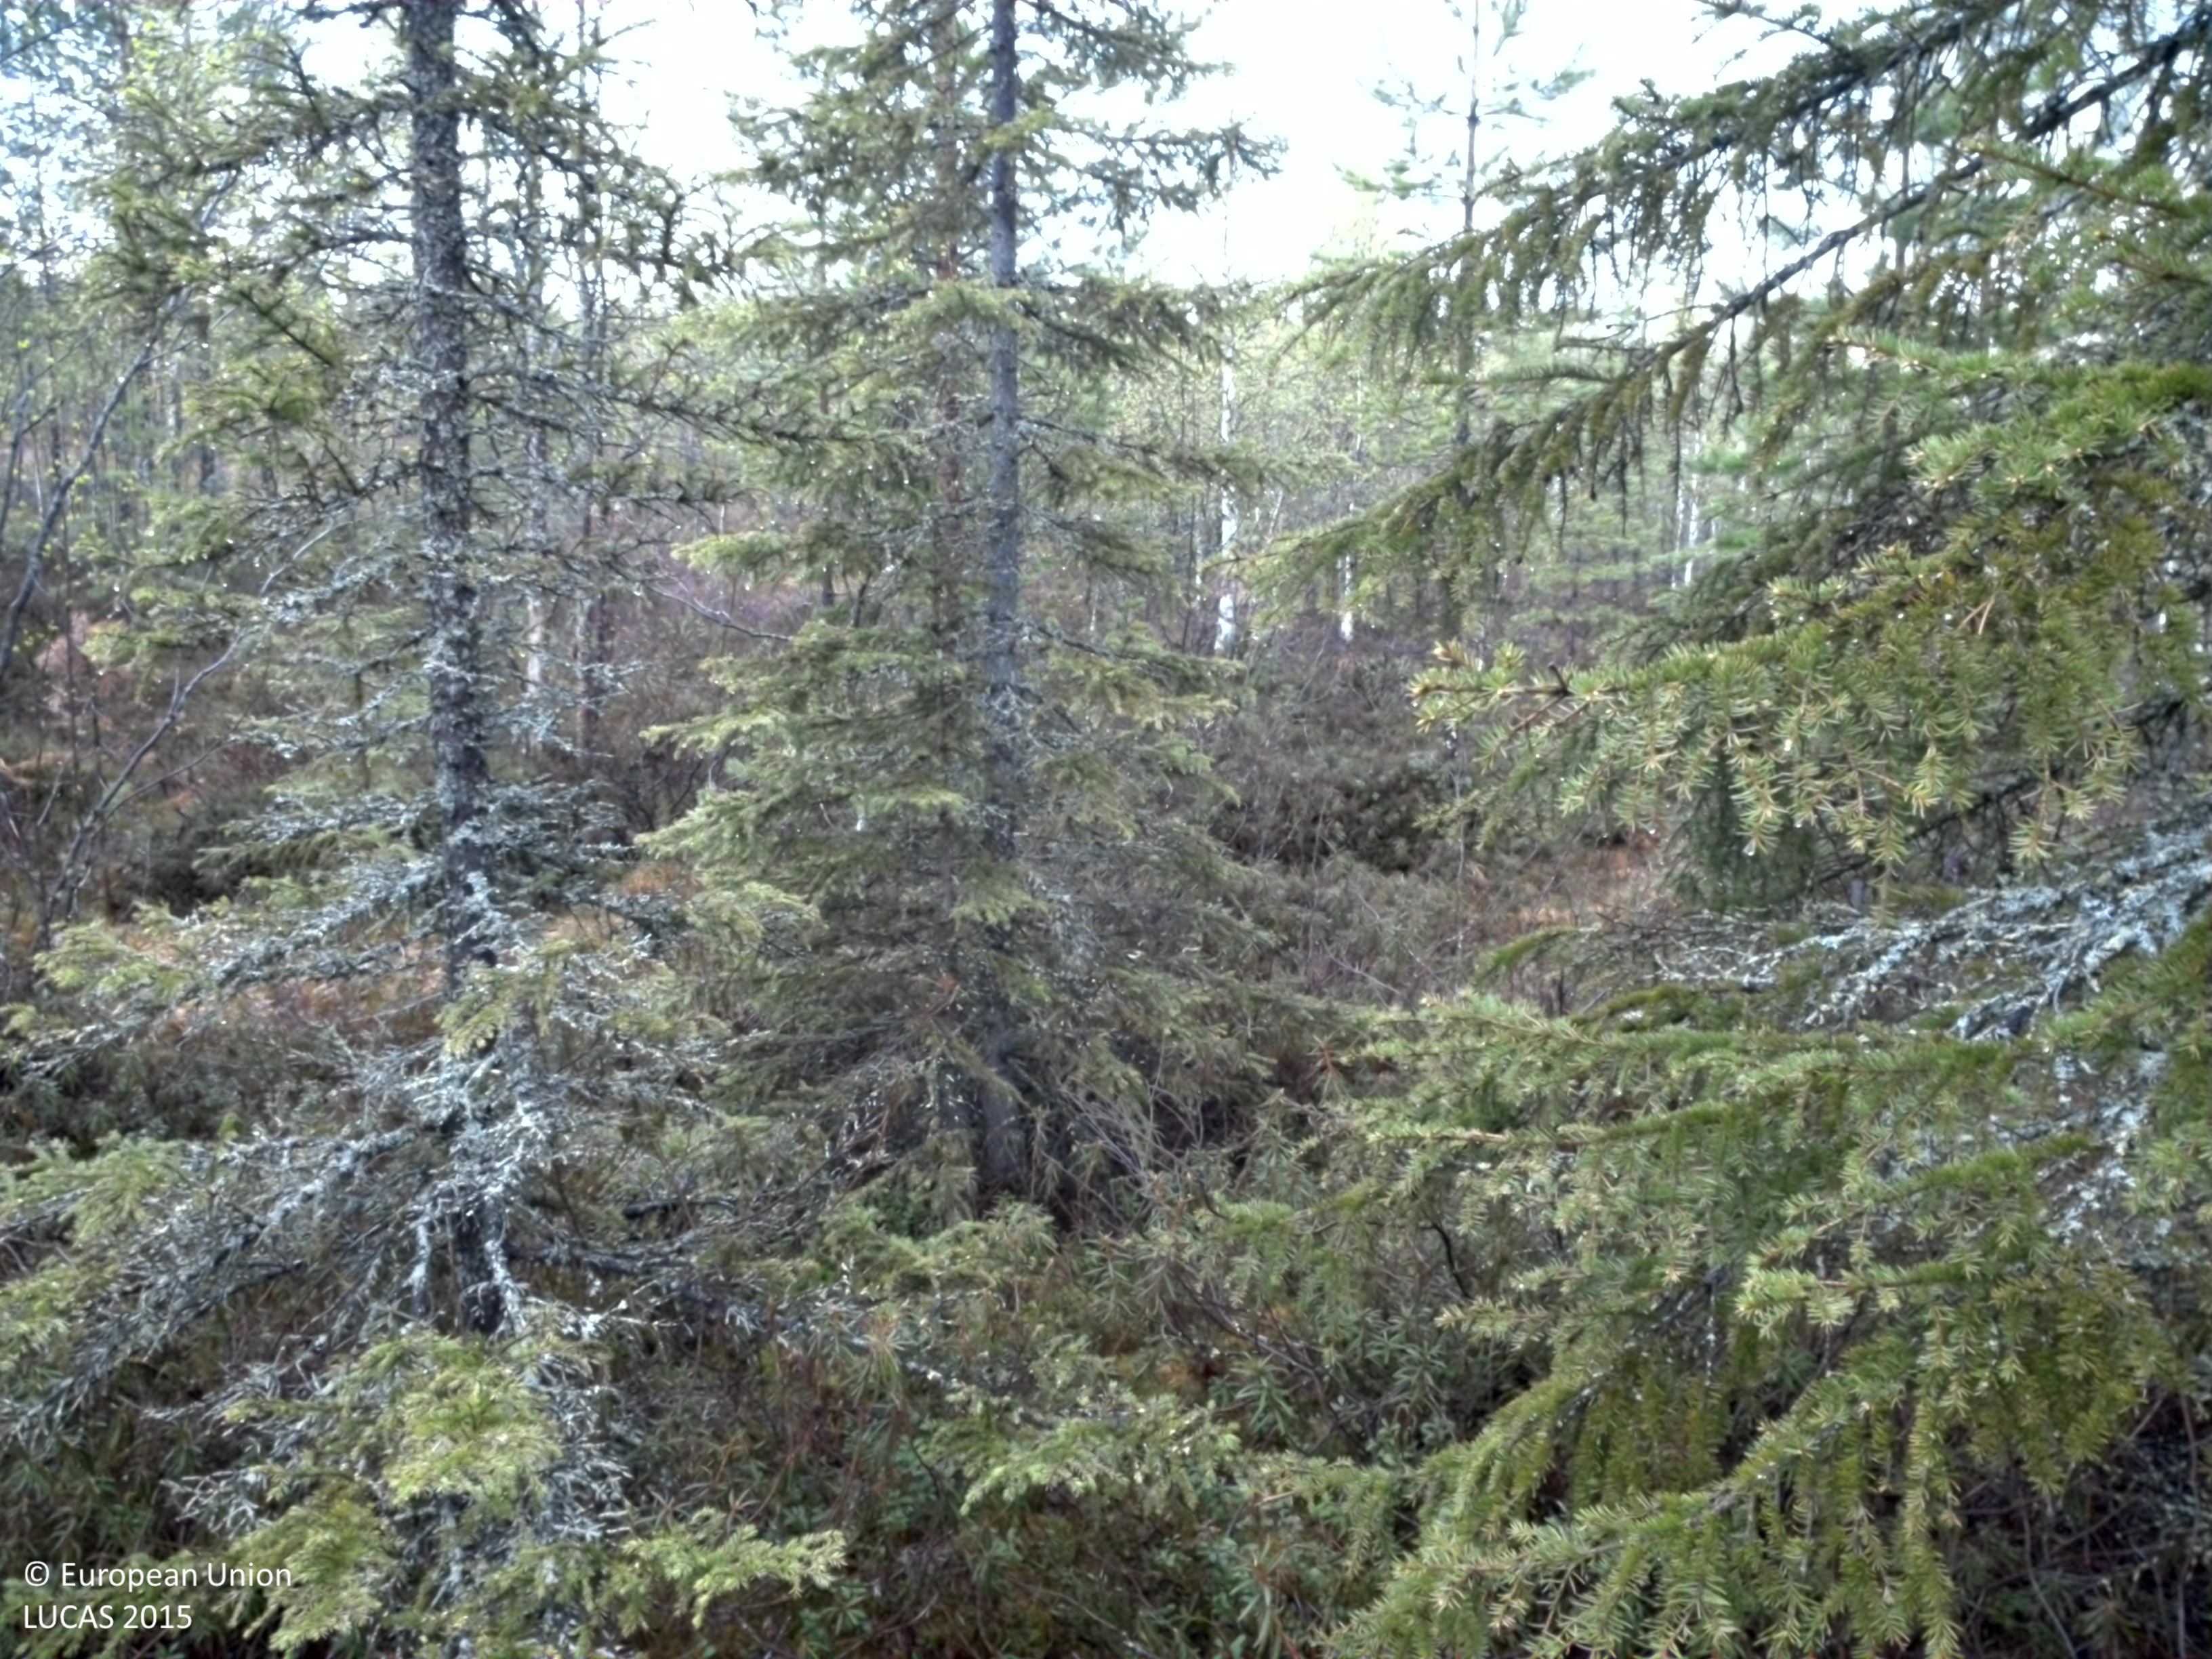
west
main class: Woodland
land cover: Pine dominated mixed woodland
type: boreal forest
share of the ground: 50 - 75 %
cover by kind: shrubs 40 %, coniferous forest trees 25 %, broadleaved forest trees 25 %, lichens and mosses 10 %
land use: Forestry
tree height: > 5 m
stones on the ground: 25 - 50 %
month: May
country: SE
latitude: 66.2185
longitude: 23.1619
